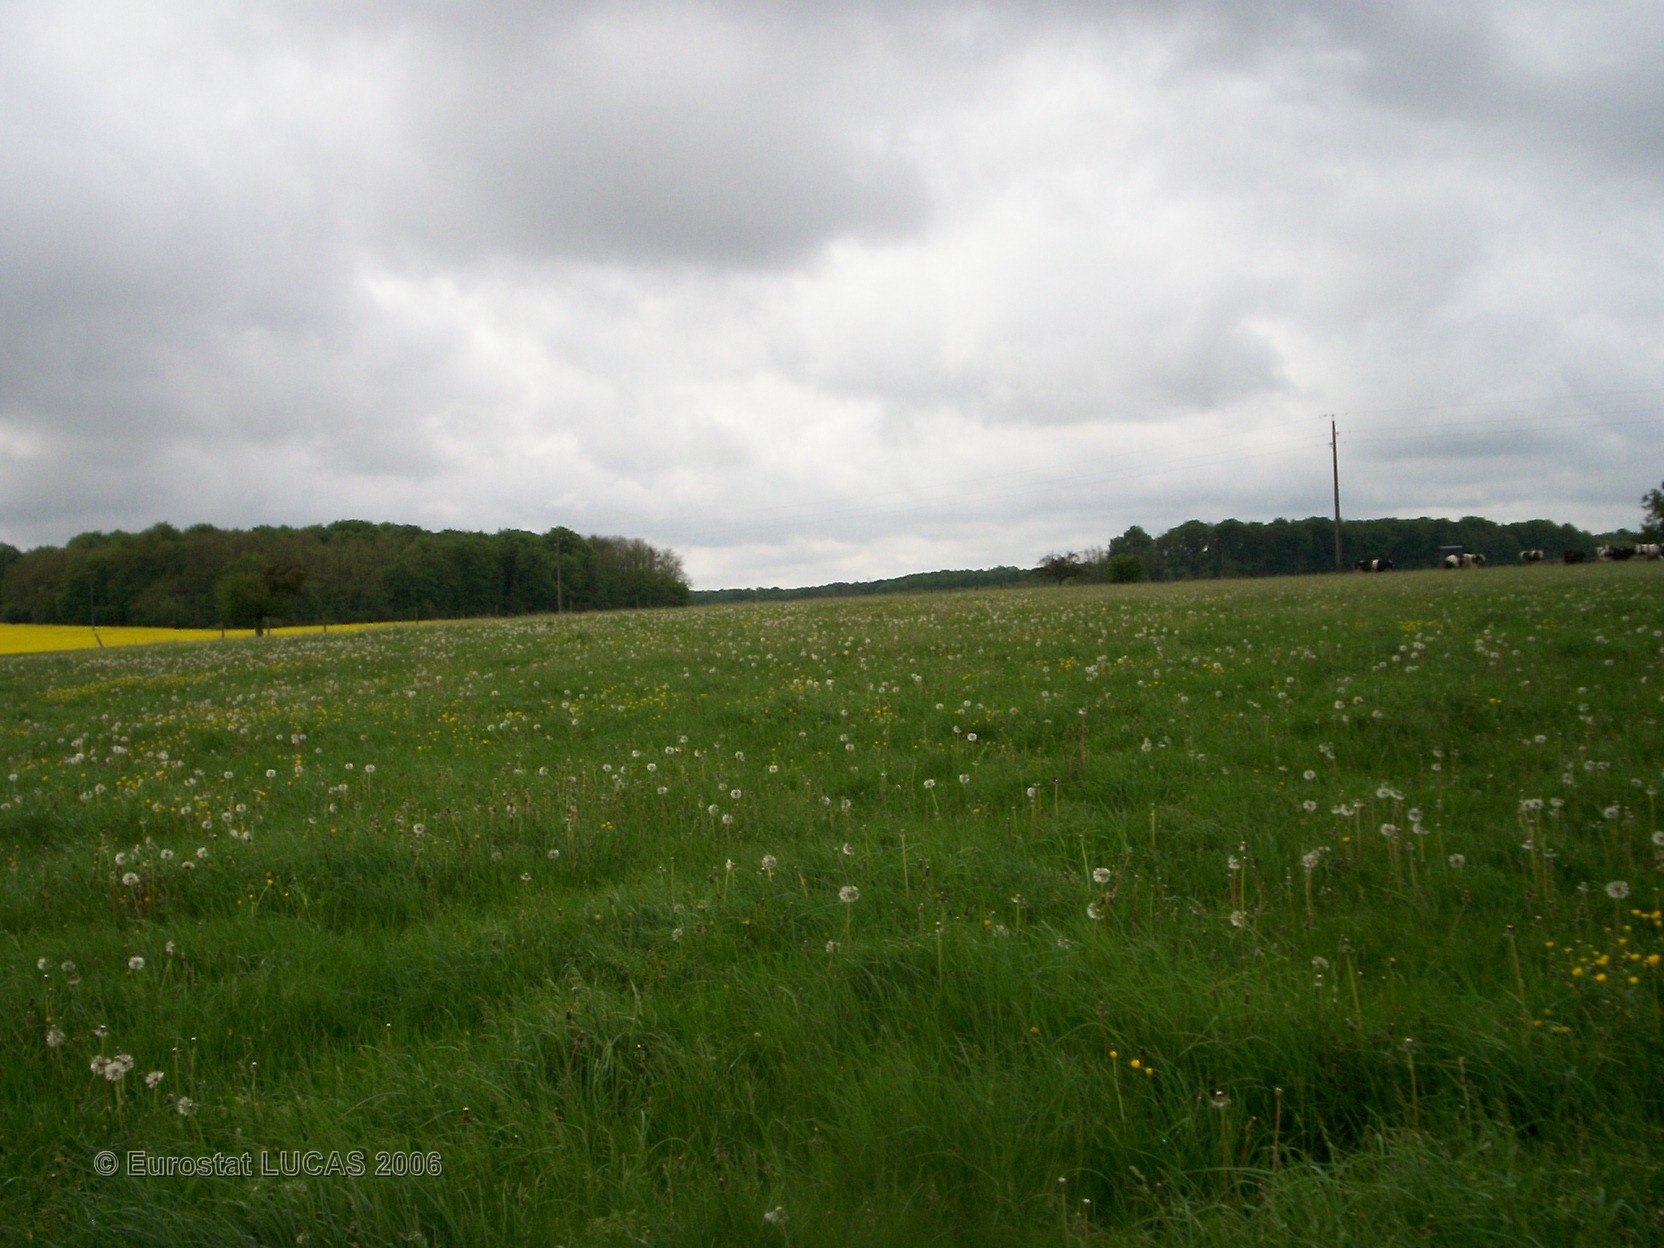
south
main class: Grassland
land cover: Grassland without tree/shrub cover
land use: Agriculture (excluding fallow land and kitchen gardens)
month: May
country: FR
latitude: 48.0144
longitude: 2.9275
